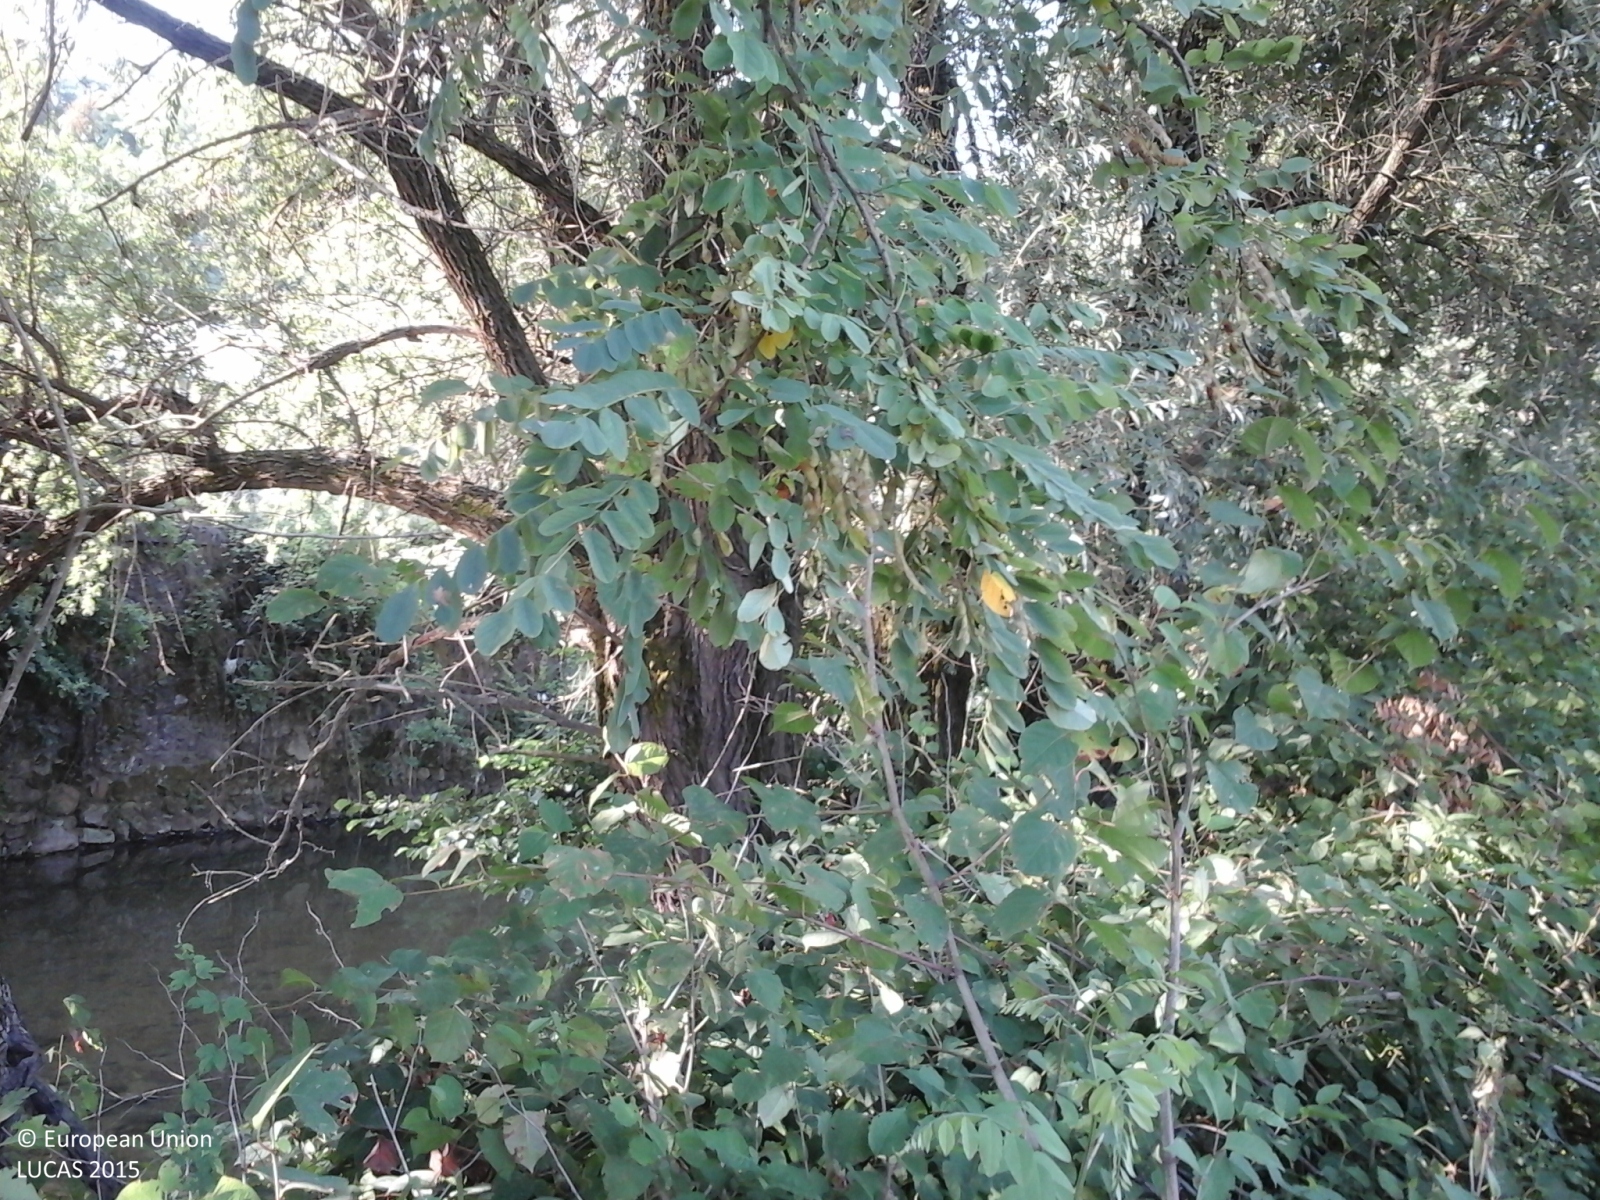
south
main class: Woodland
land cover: Broadleaved woodland
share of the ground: > 75 %
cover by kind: broadleaved forest trees 95 %, shrubs 5 %
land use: Semi-natural and natural areas not in use
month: August
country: IT
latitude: 44.4001
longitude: 7.8325
